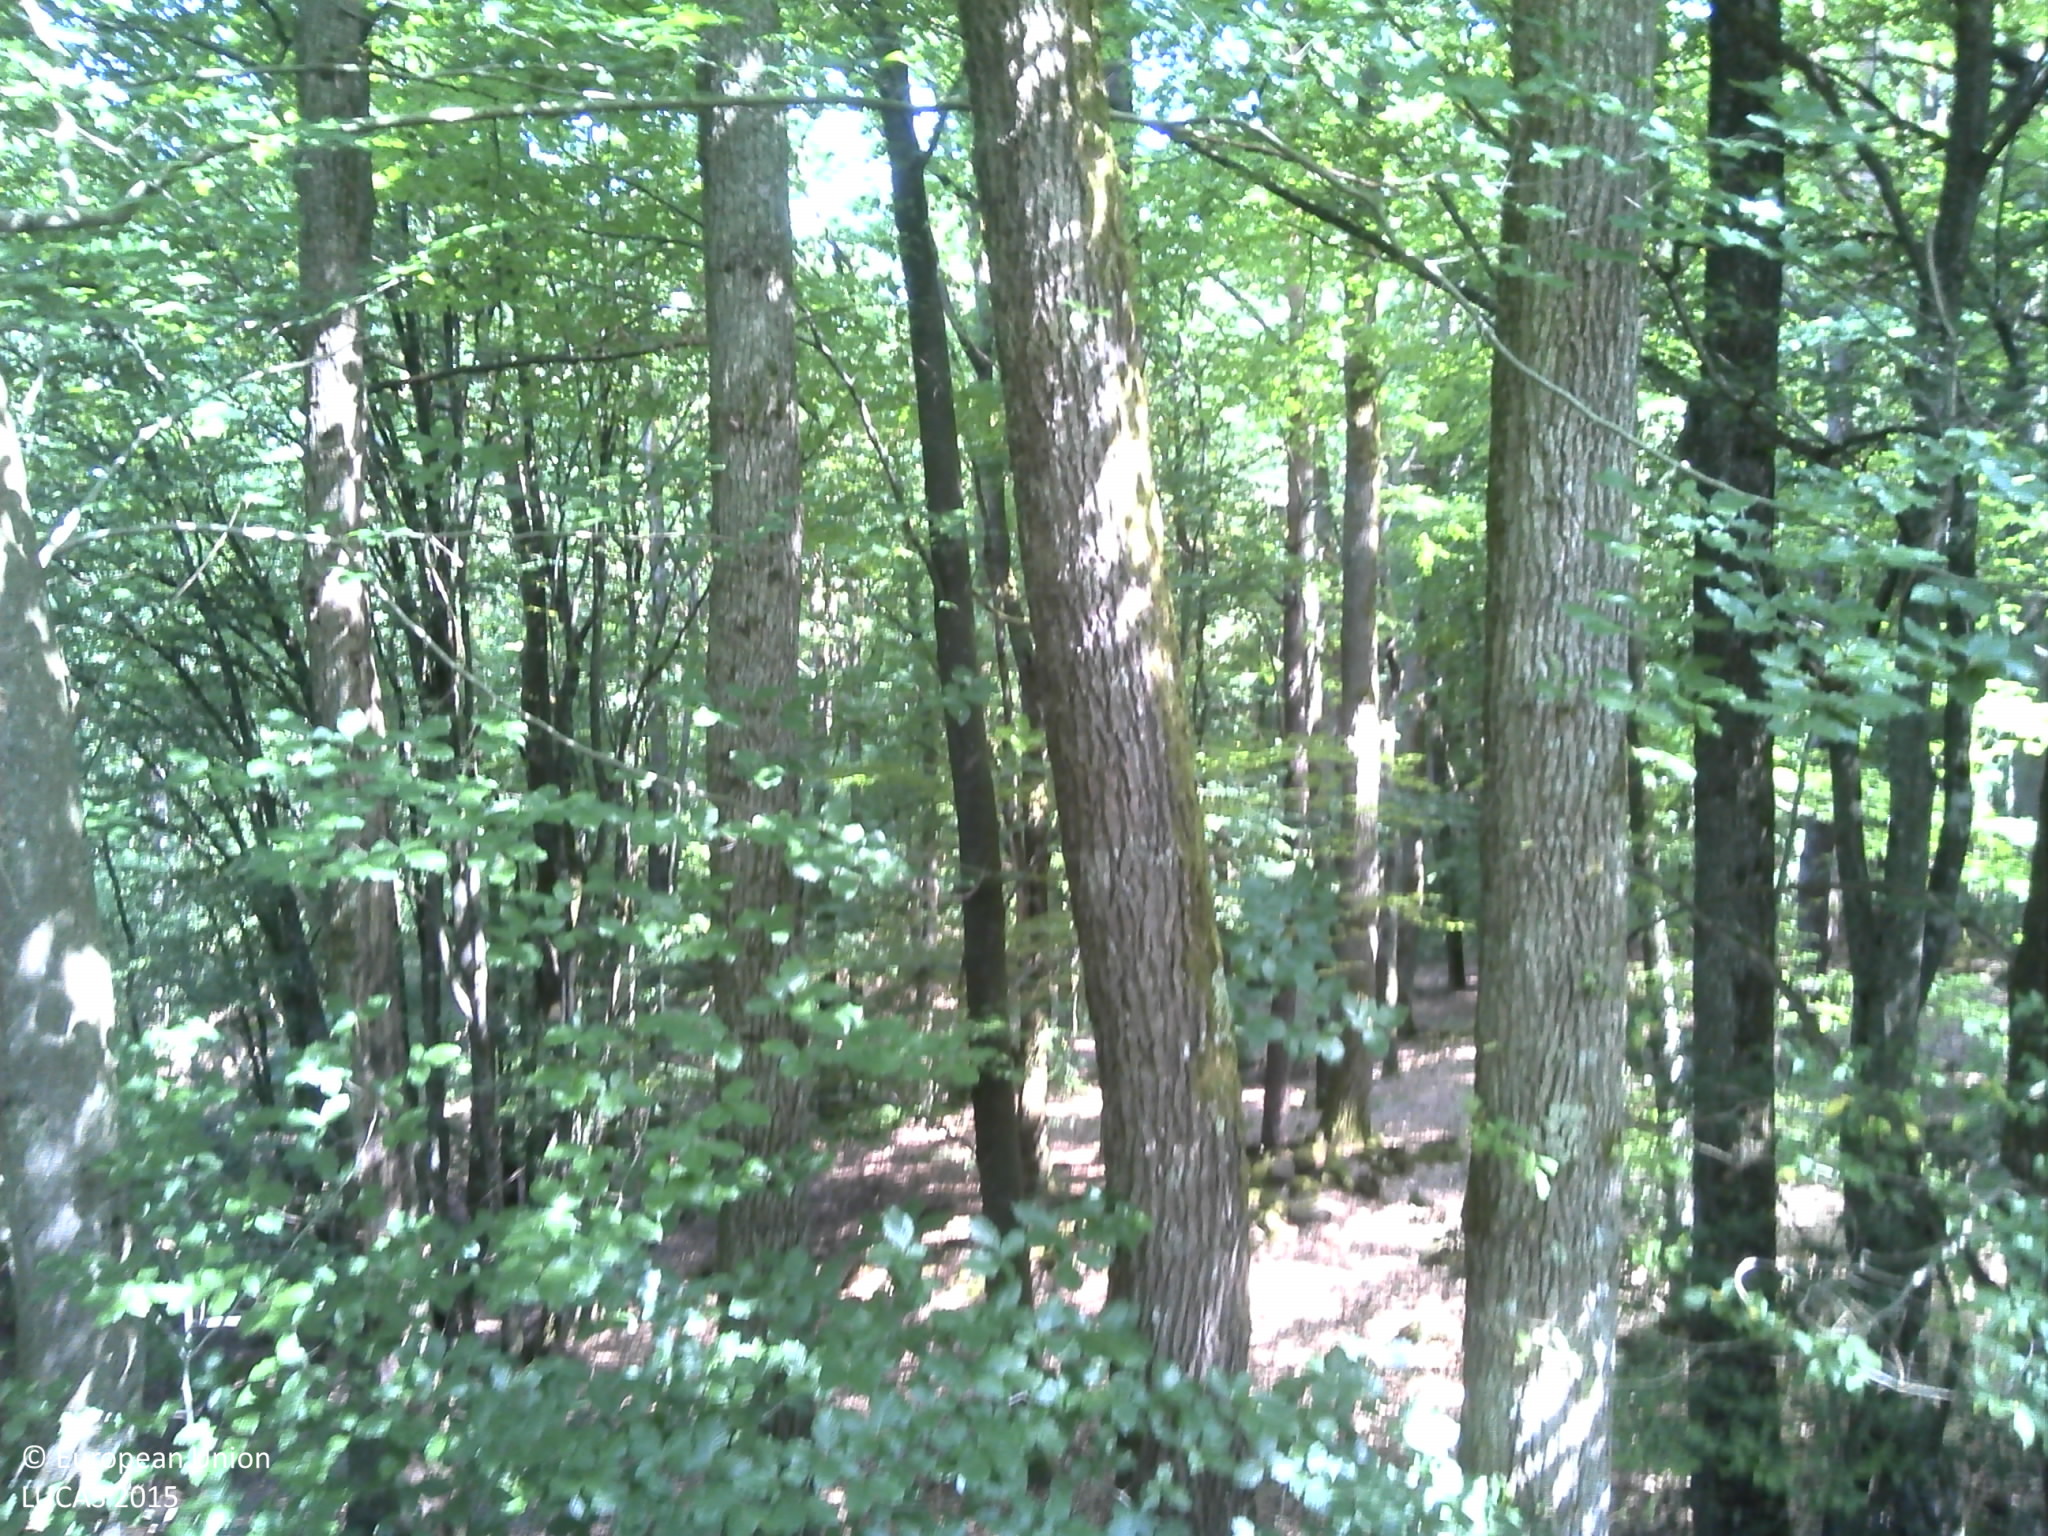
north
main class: Woodland
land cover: Broadleaved woodland
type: acidophilous oak and oak-birch forest
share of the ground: > 75 %
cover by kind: broadleaved forest trees 90 %, lichens and mosses 10 %
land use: Forestry
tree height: > 5 m
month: July
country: FR
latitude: 48.9699
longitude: 7.5280
